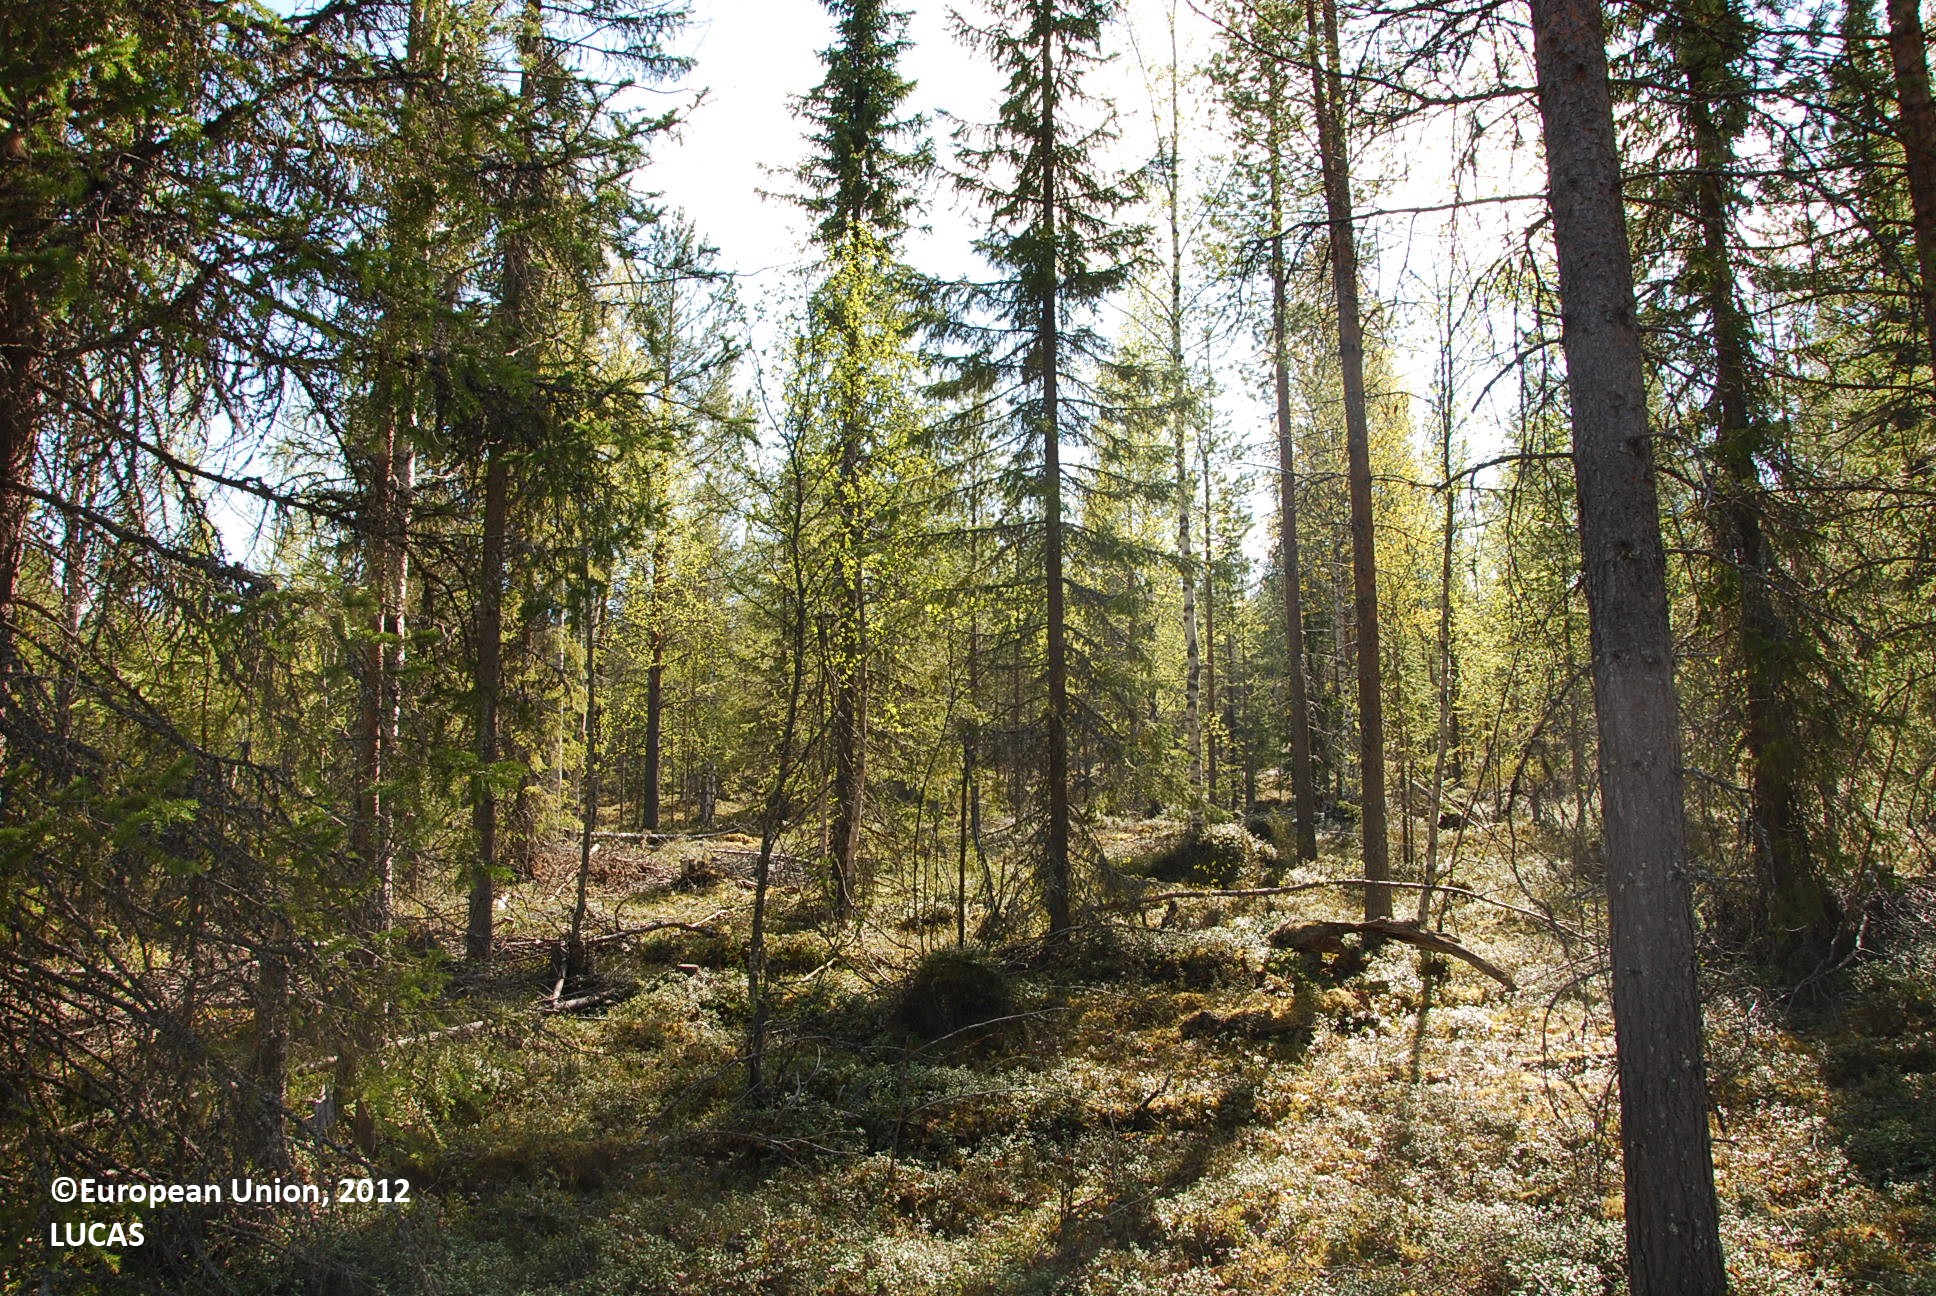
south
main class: Woodland
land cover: Spruce dominated mixed woodland
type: boreal forest
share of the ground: 50 - 75 %
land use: Forestry
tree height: > 5 m
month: June
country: FI
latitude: 66.9655
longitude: 28.2925
